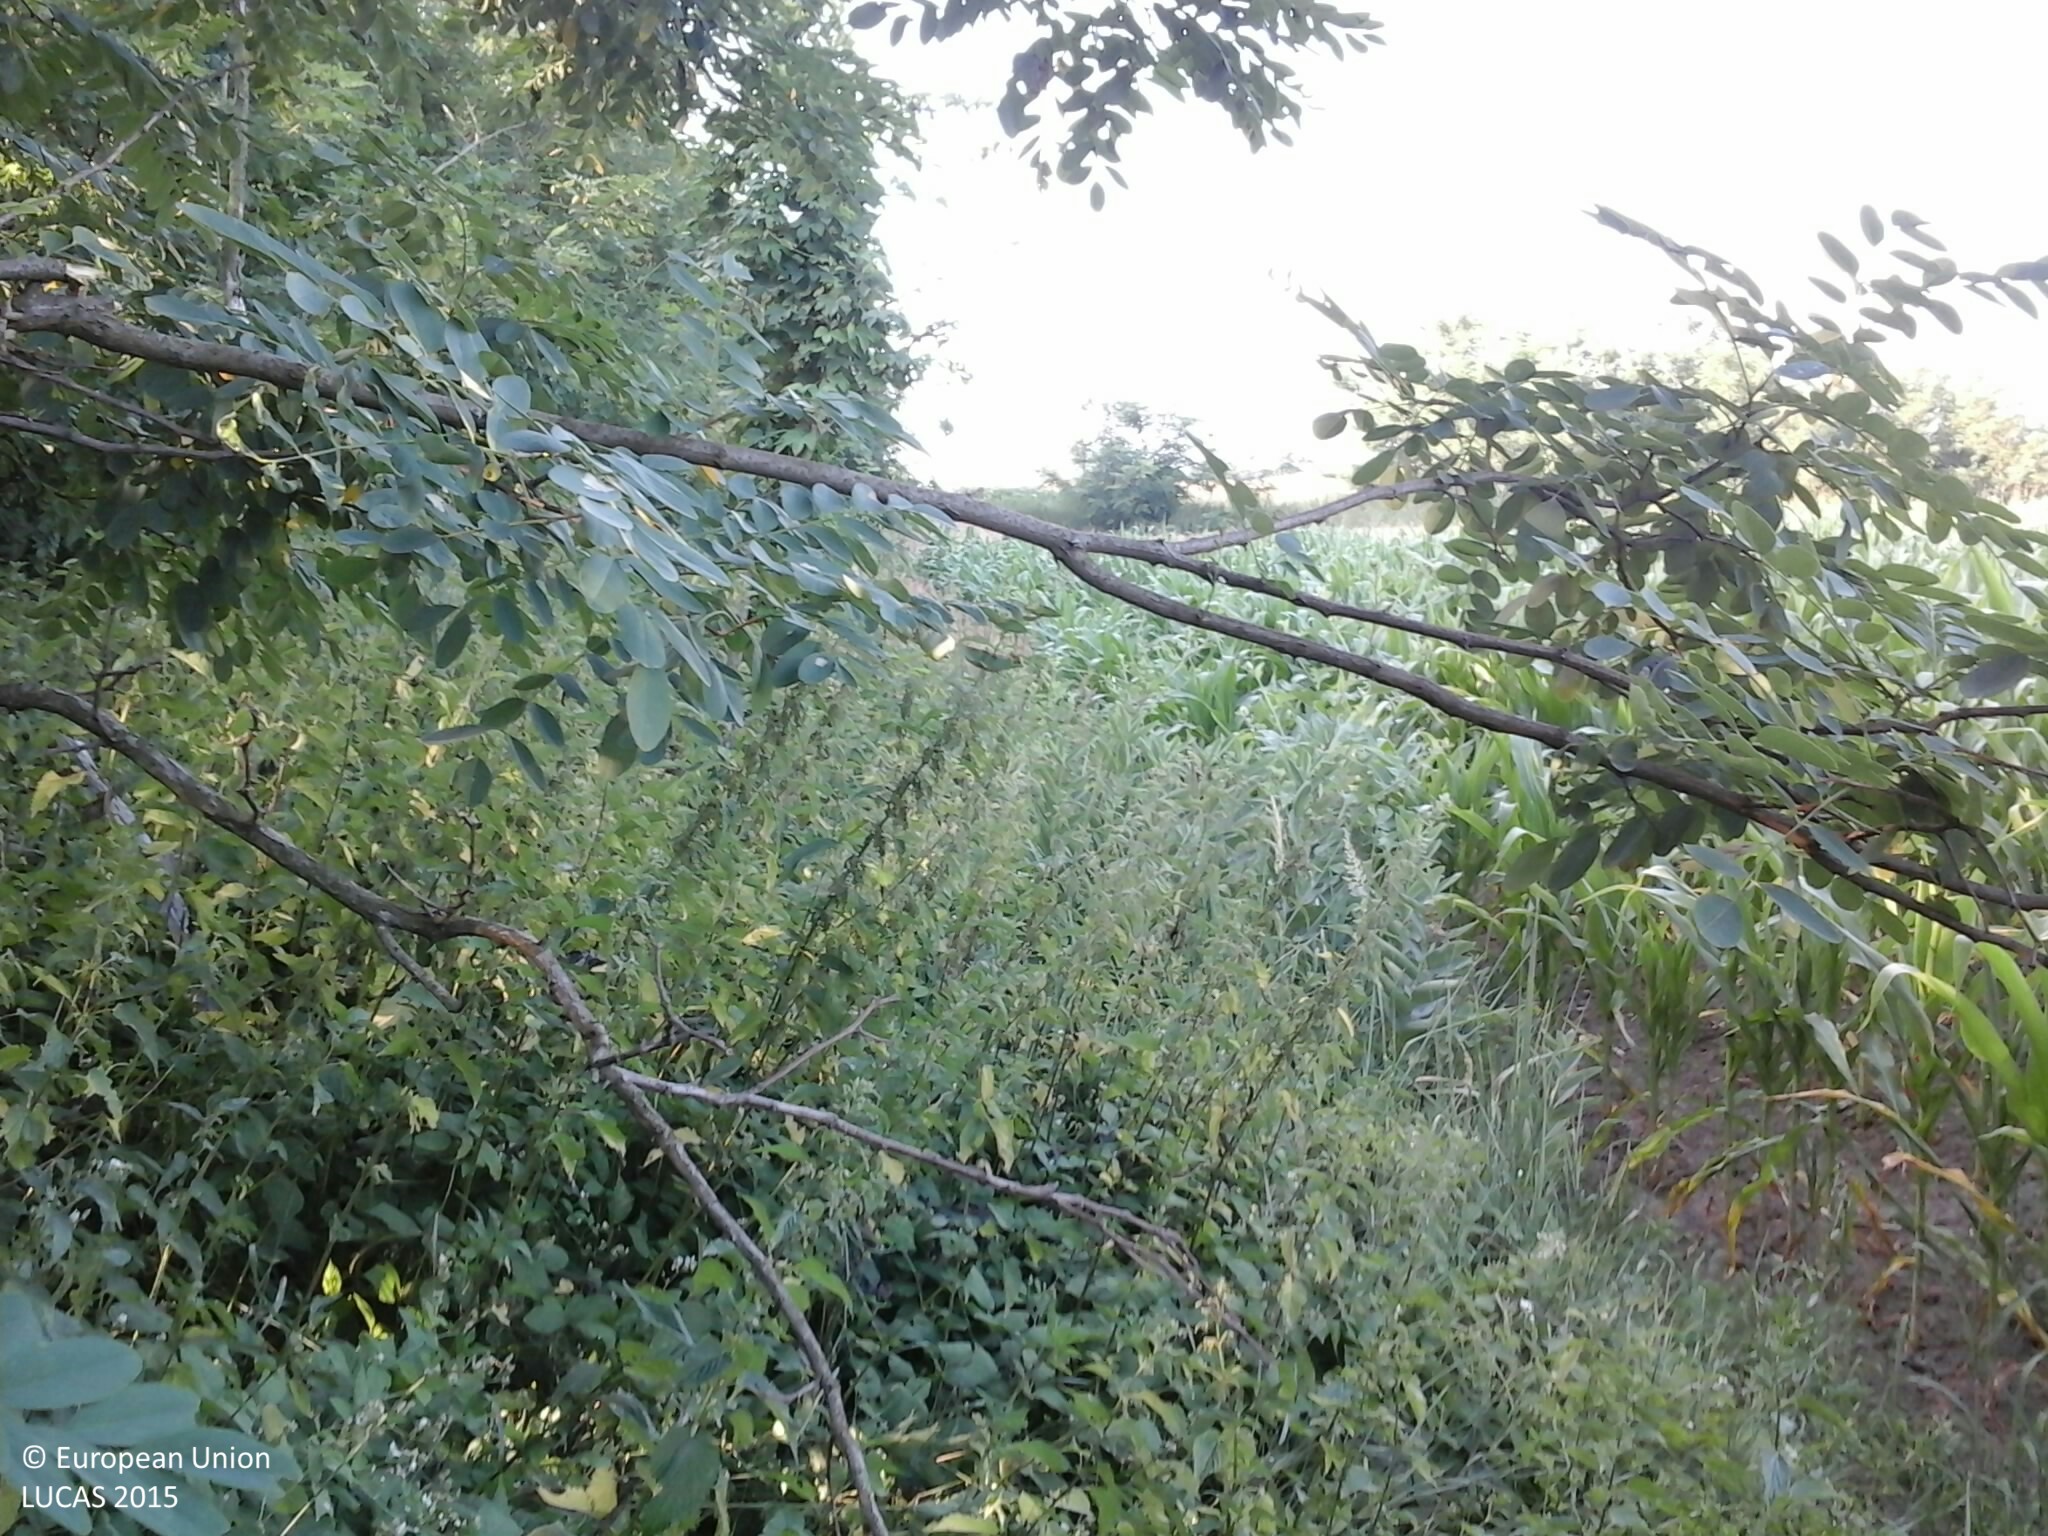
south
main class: Woodland
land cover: Broadleaved woodland
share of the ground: 50 - 75 %
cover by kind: broadleaved forest trees 90 %, herbaceous plants 10 %
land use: Forestry
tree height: > 5 m
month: July
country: HU
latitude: 47.8488
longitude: 21.9035
